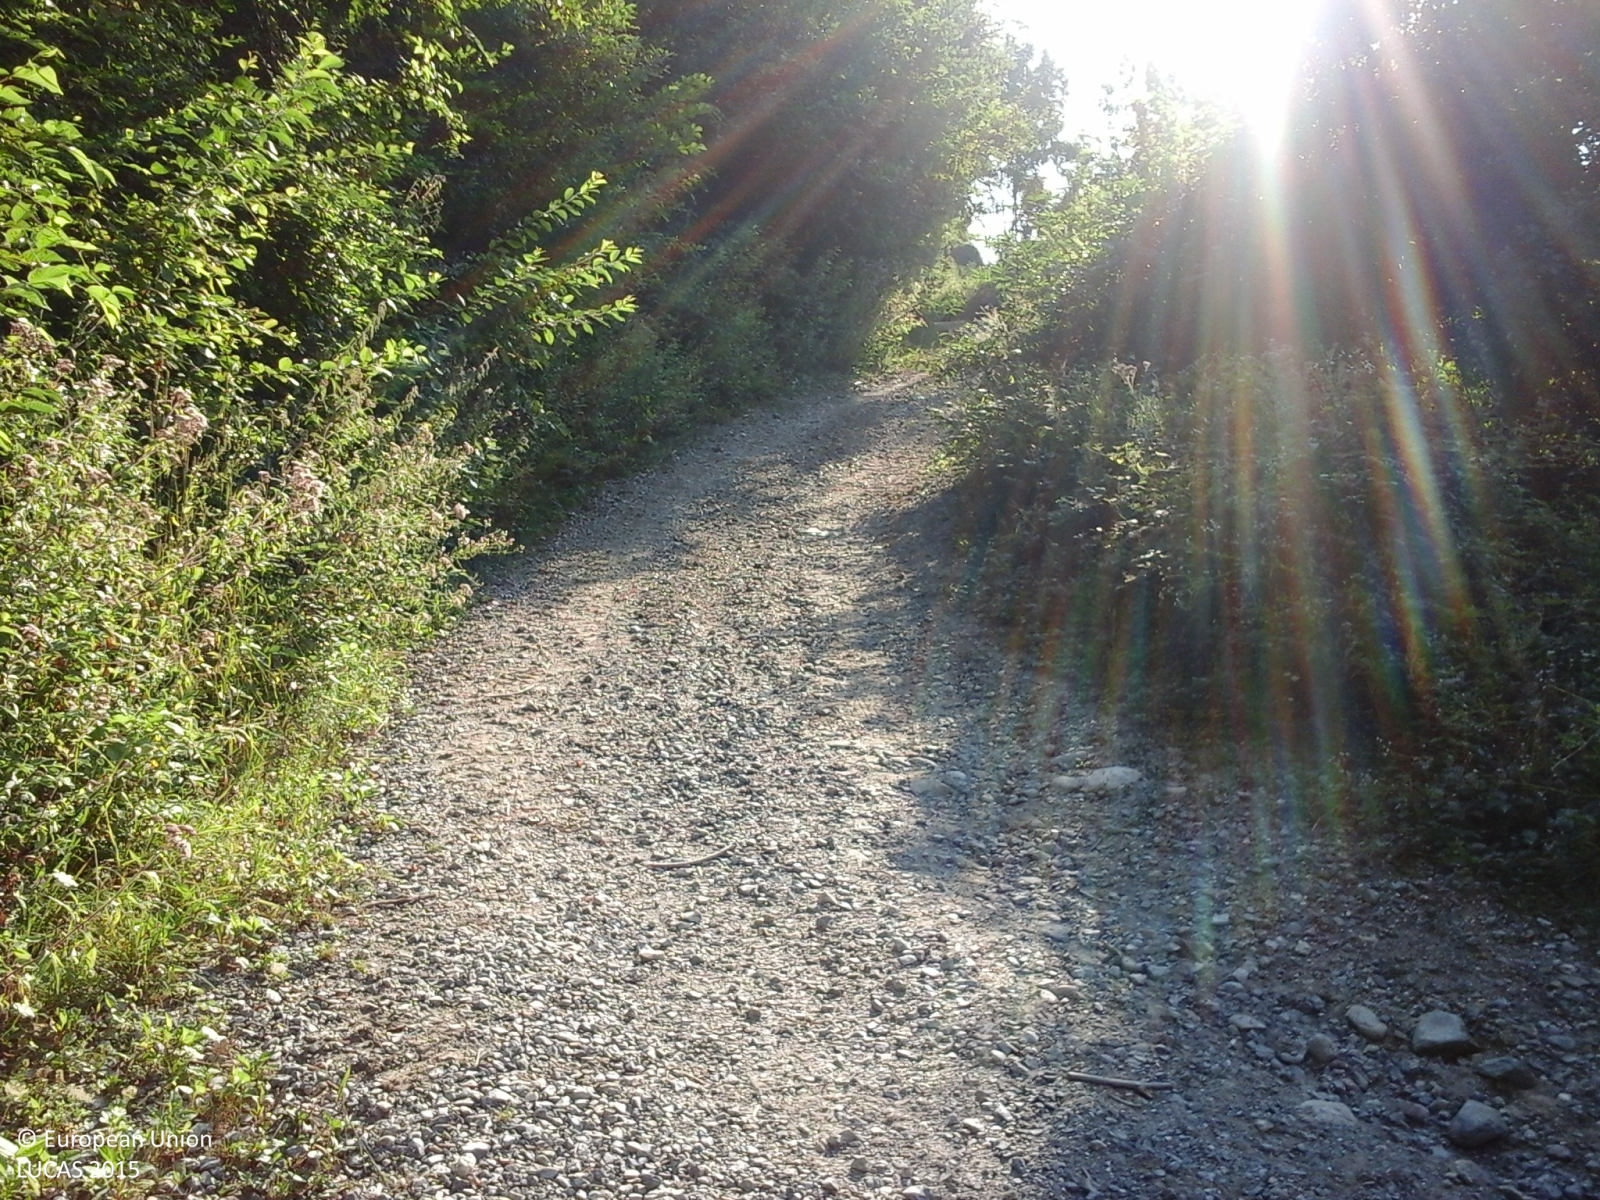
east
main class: Woodland
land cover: Broadleaved woodland
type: thermophilous deciduous forest
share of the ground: > 75 %
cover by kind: broadleaved forest trees 90 %, shrubs 10 %
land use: Forestry
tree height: > 5 m
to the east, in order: Broadleaved woodland; Tracks; Broadleaved woodland; Tracks; Broadleaved woodland
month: August
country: IT
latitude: 44.1697
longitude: 8.0410
